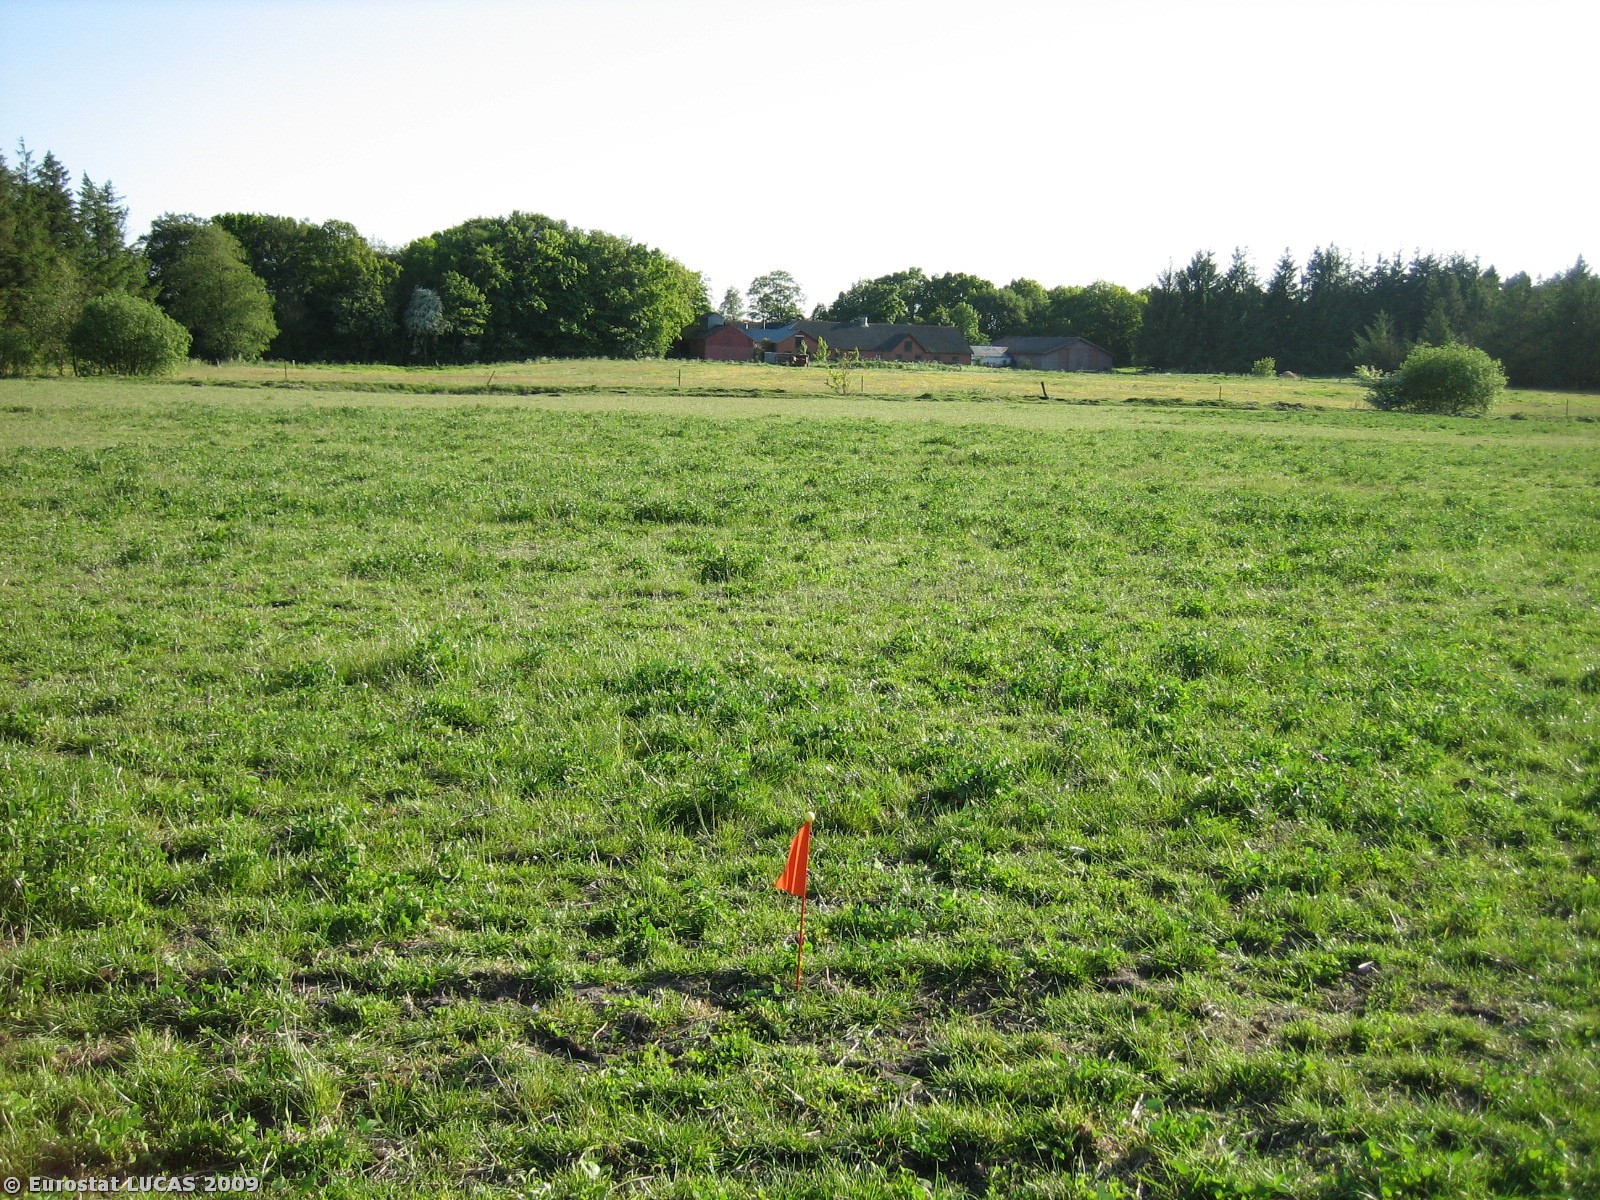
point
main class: Grassland
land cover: Grassland without tree/shrub cover
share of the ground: > 75 %
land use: Agriculture (excluding fallow land and kitchen gardens)
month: May
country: DK
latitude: 55.8422
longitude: 8.9950
